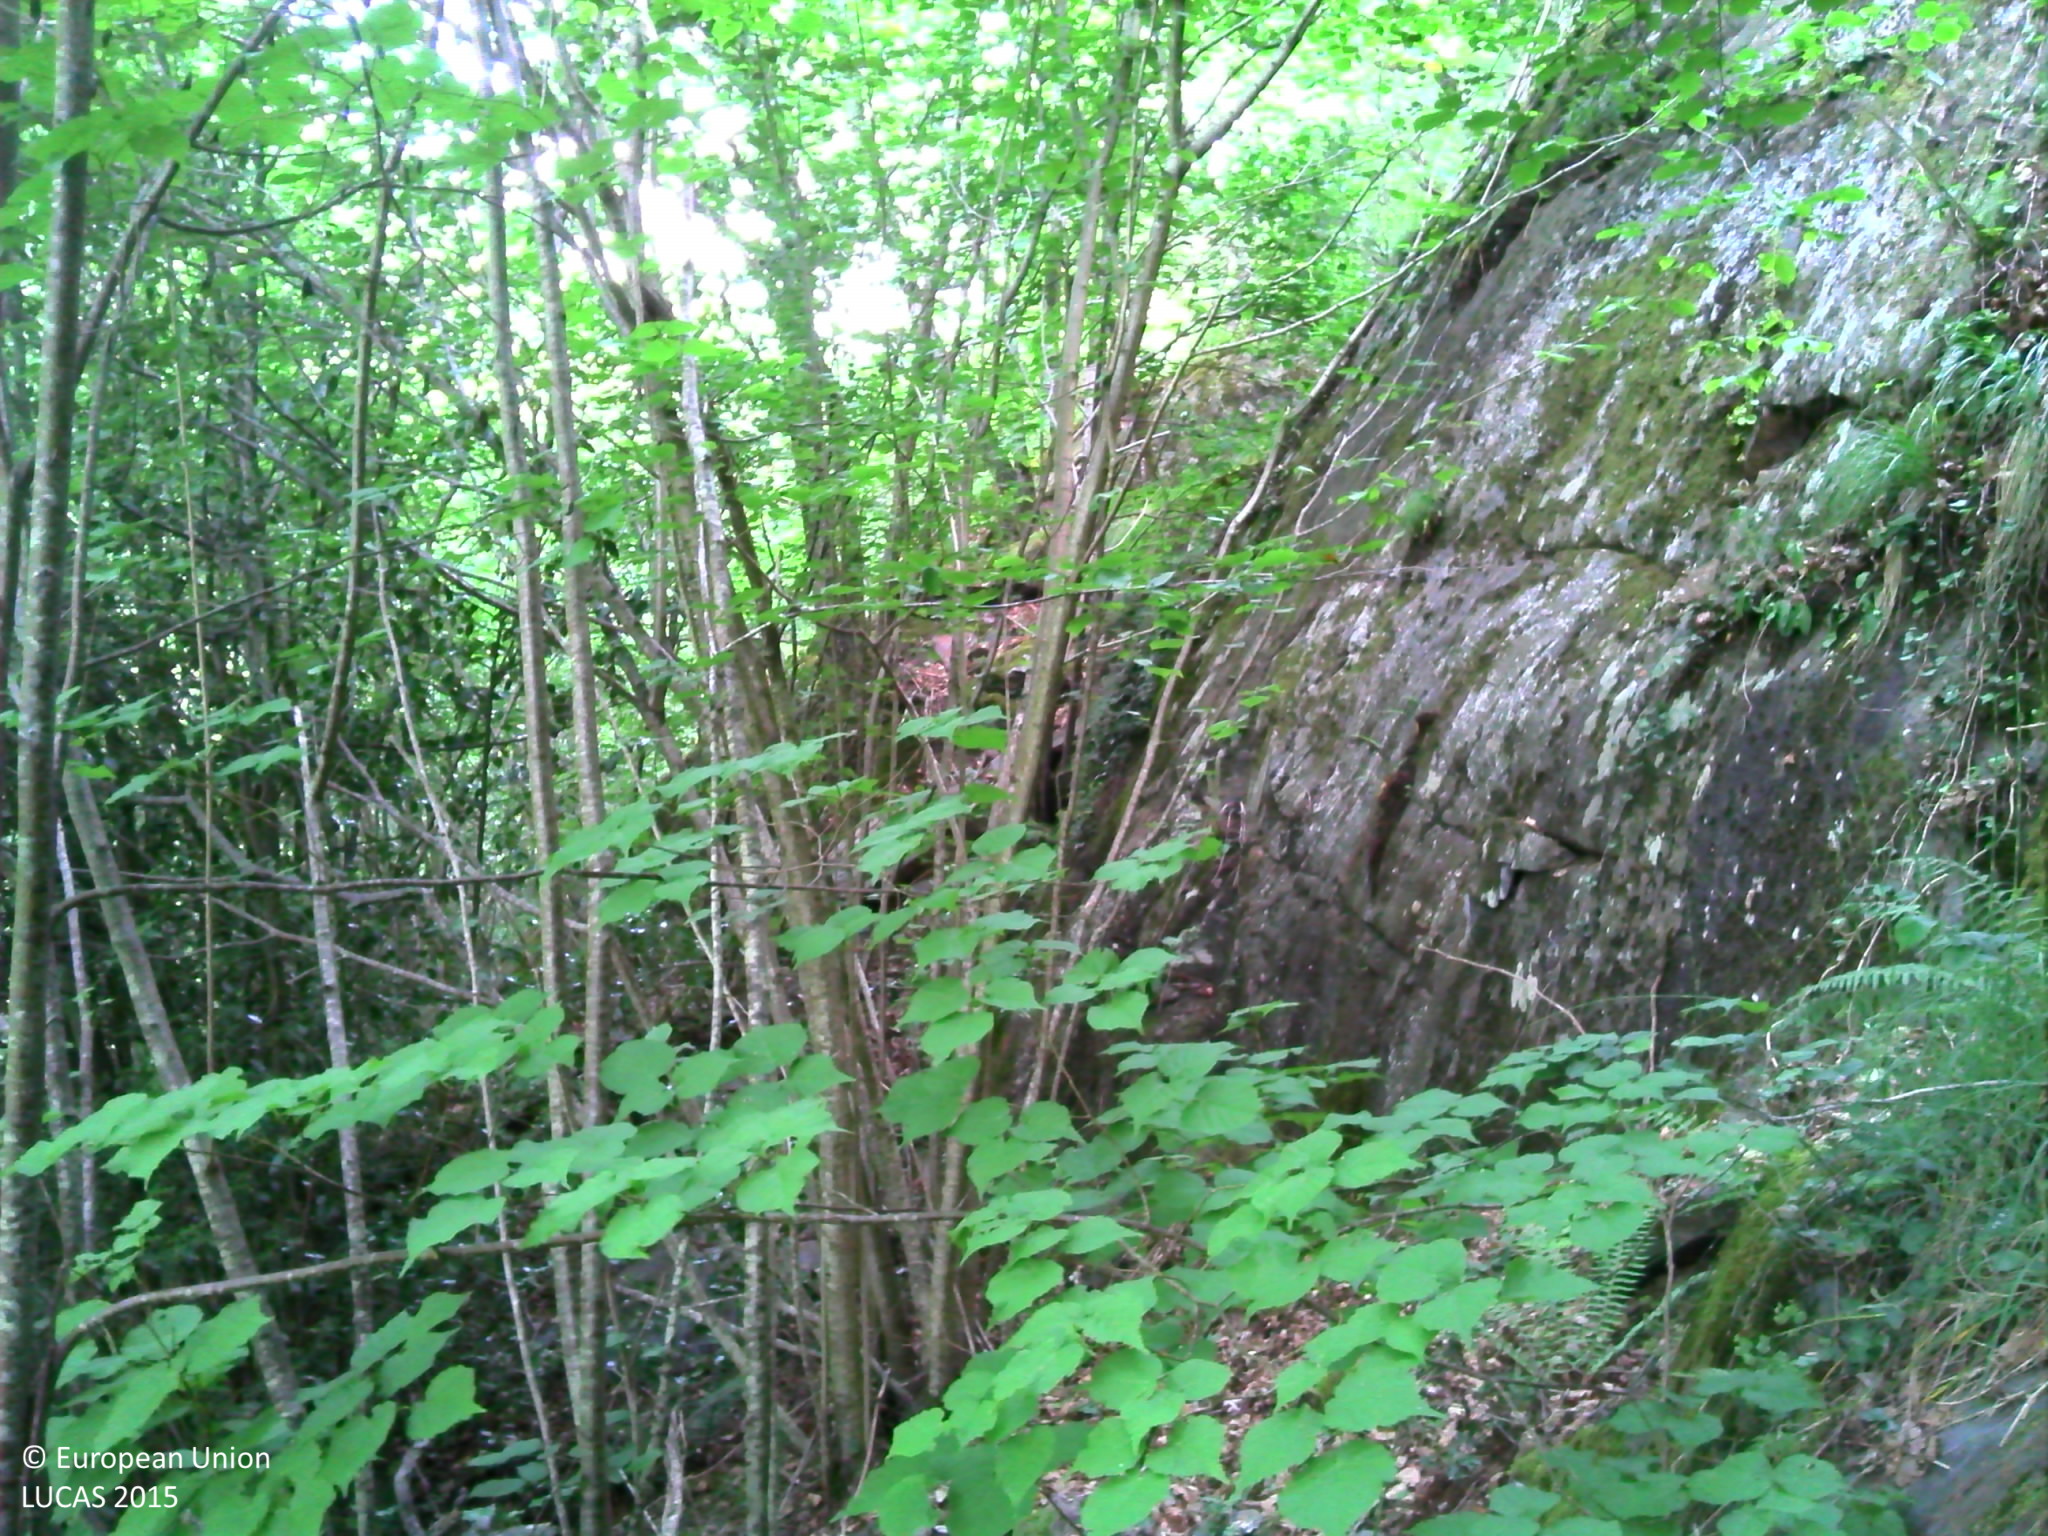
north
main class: Woodland
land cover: Broadleaved woodland
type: mesophytic deciduous forest
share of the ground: > 75 %
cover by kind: broadleaved forest trees 80 %, unconsolidated bare surface 10 %, shrubs 5 %, herbaceous plants 5 %
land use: Semi-natural and natural areas not in use
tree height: > 5 m
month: July
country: FR
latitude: 42.9312
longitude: -0.0863
